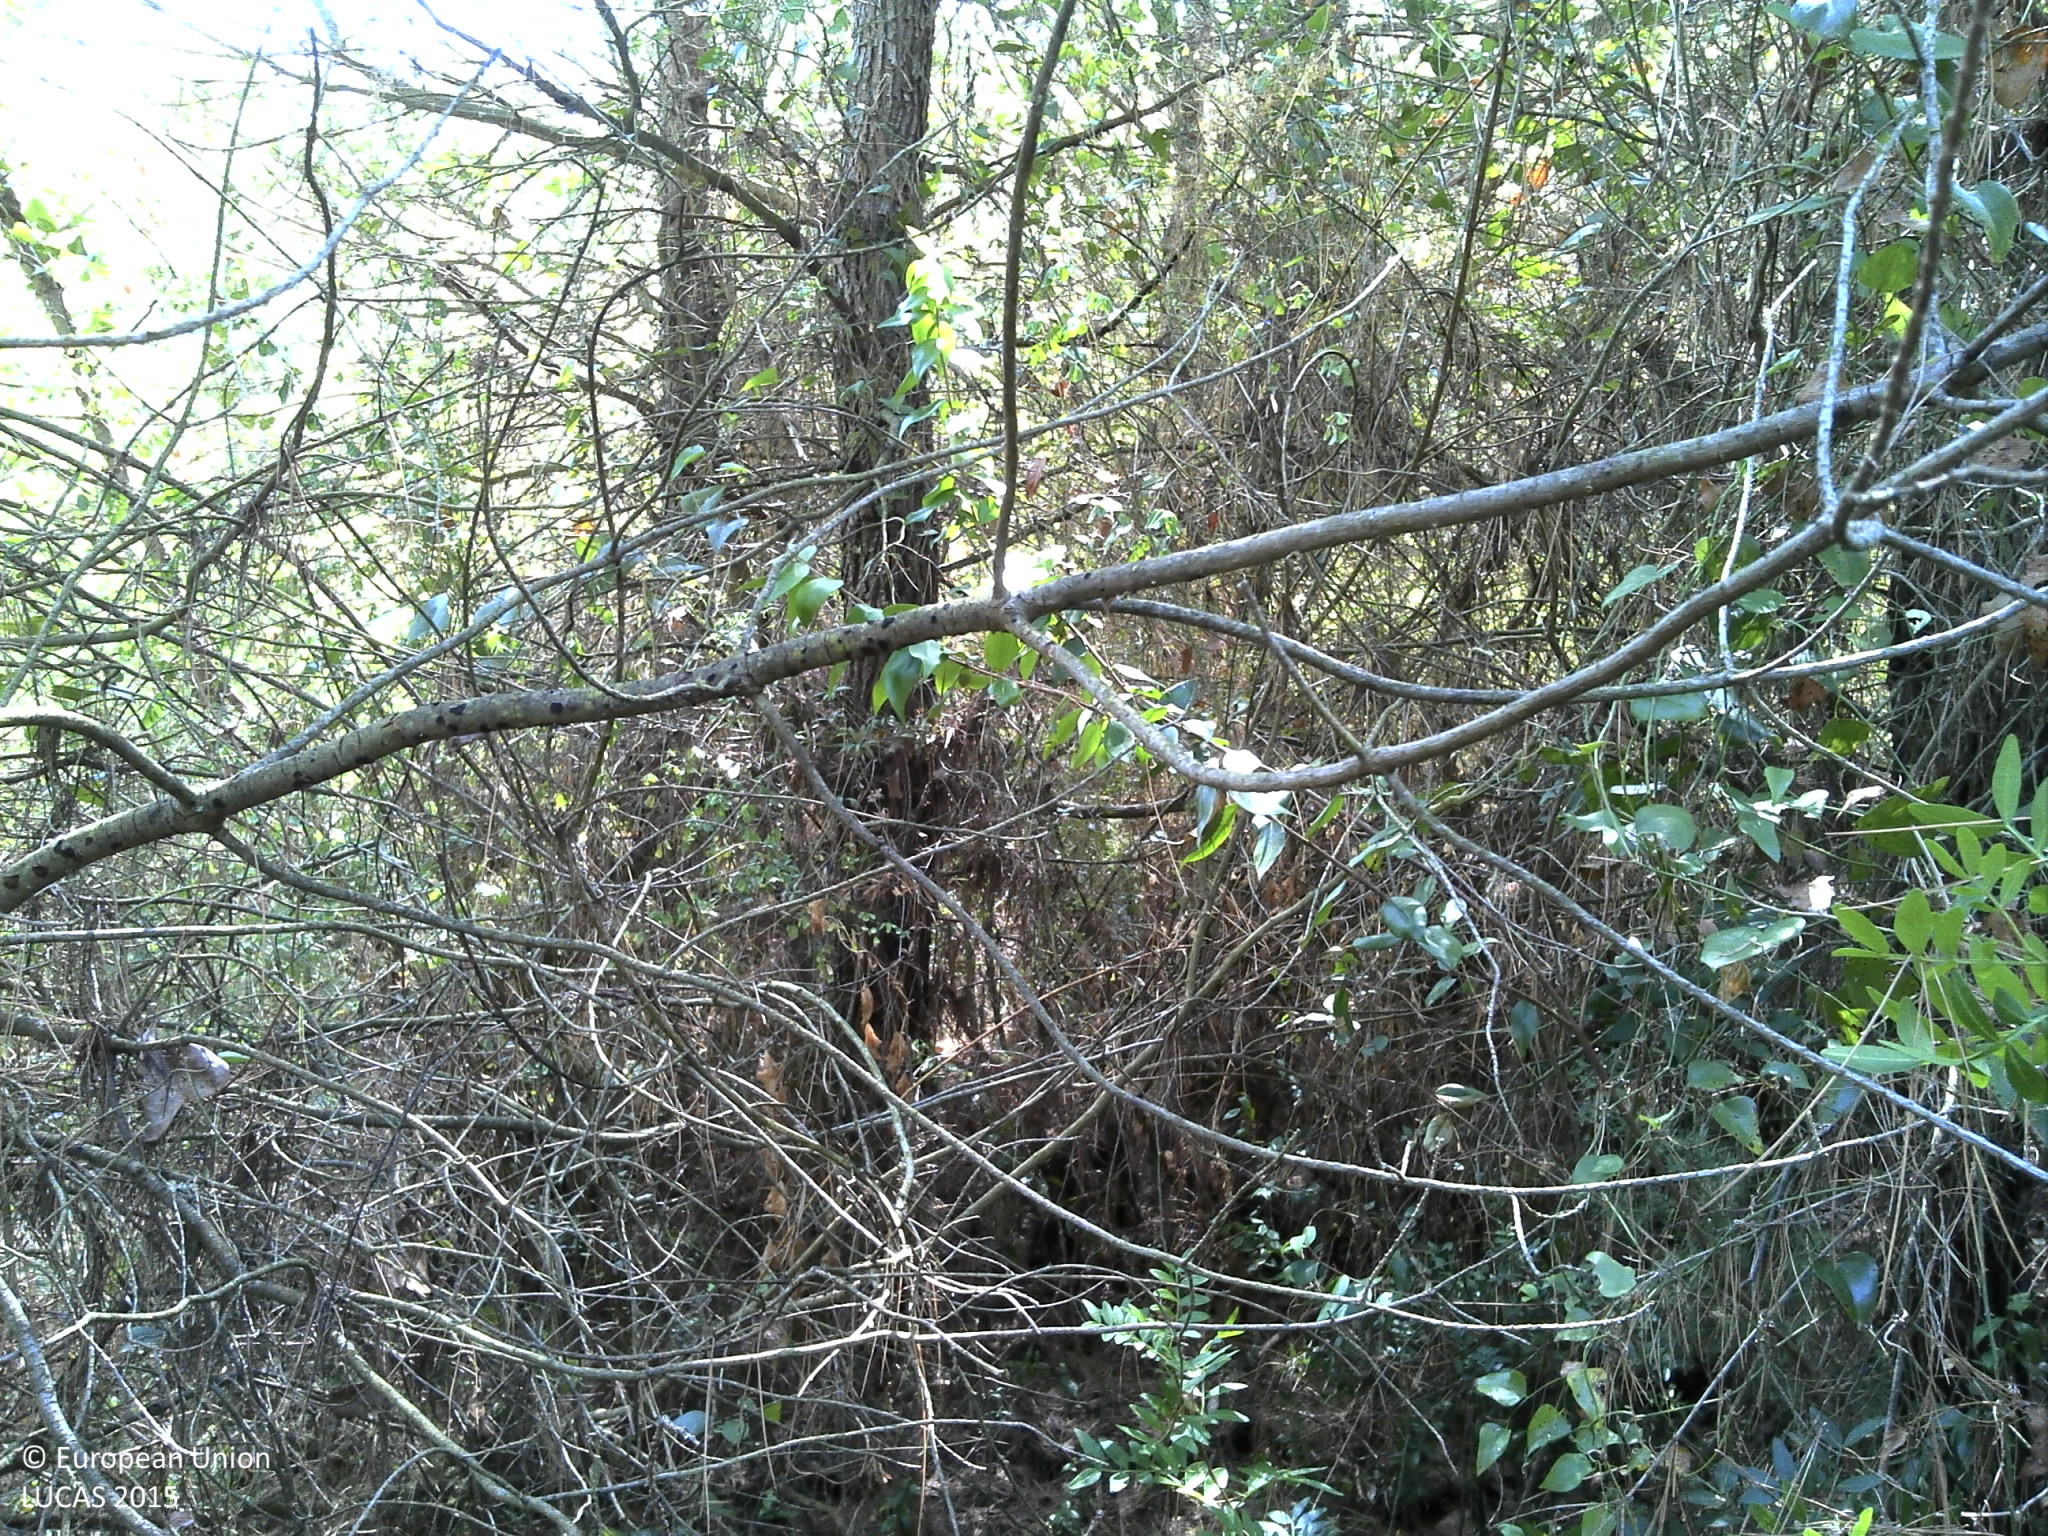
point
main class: Woodland
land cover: Pine dominated coniferous woodland
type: coniferous forest of the mediterranean region
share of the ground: > 75 %
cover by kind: coniferous forest trees 80 %, shrubs 20 %
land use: Semi-natural and natural areas not in use
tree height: > 5 m
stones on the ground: < 10 %
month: July
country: HR
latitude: 43.5071
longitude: 16.3111
